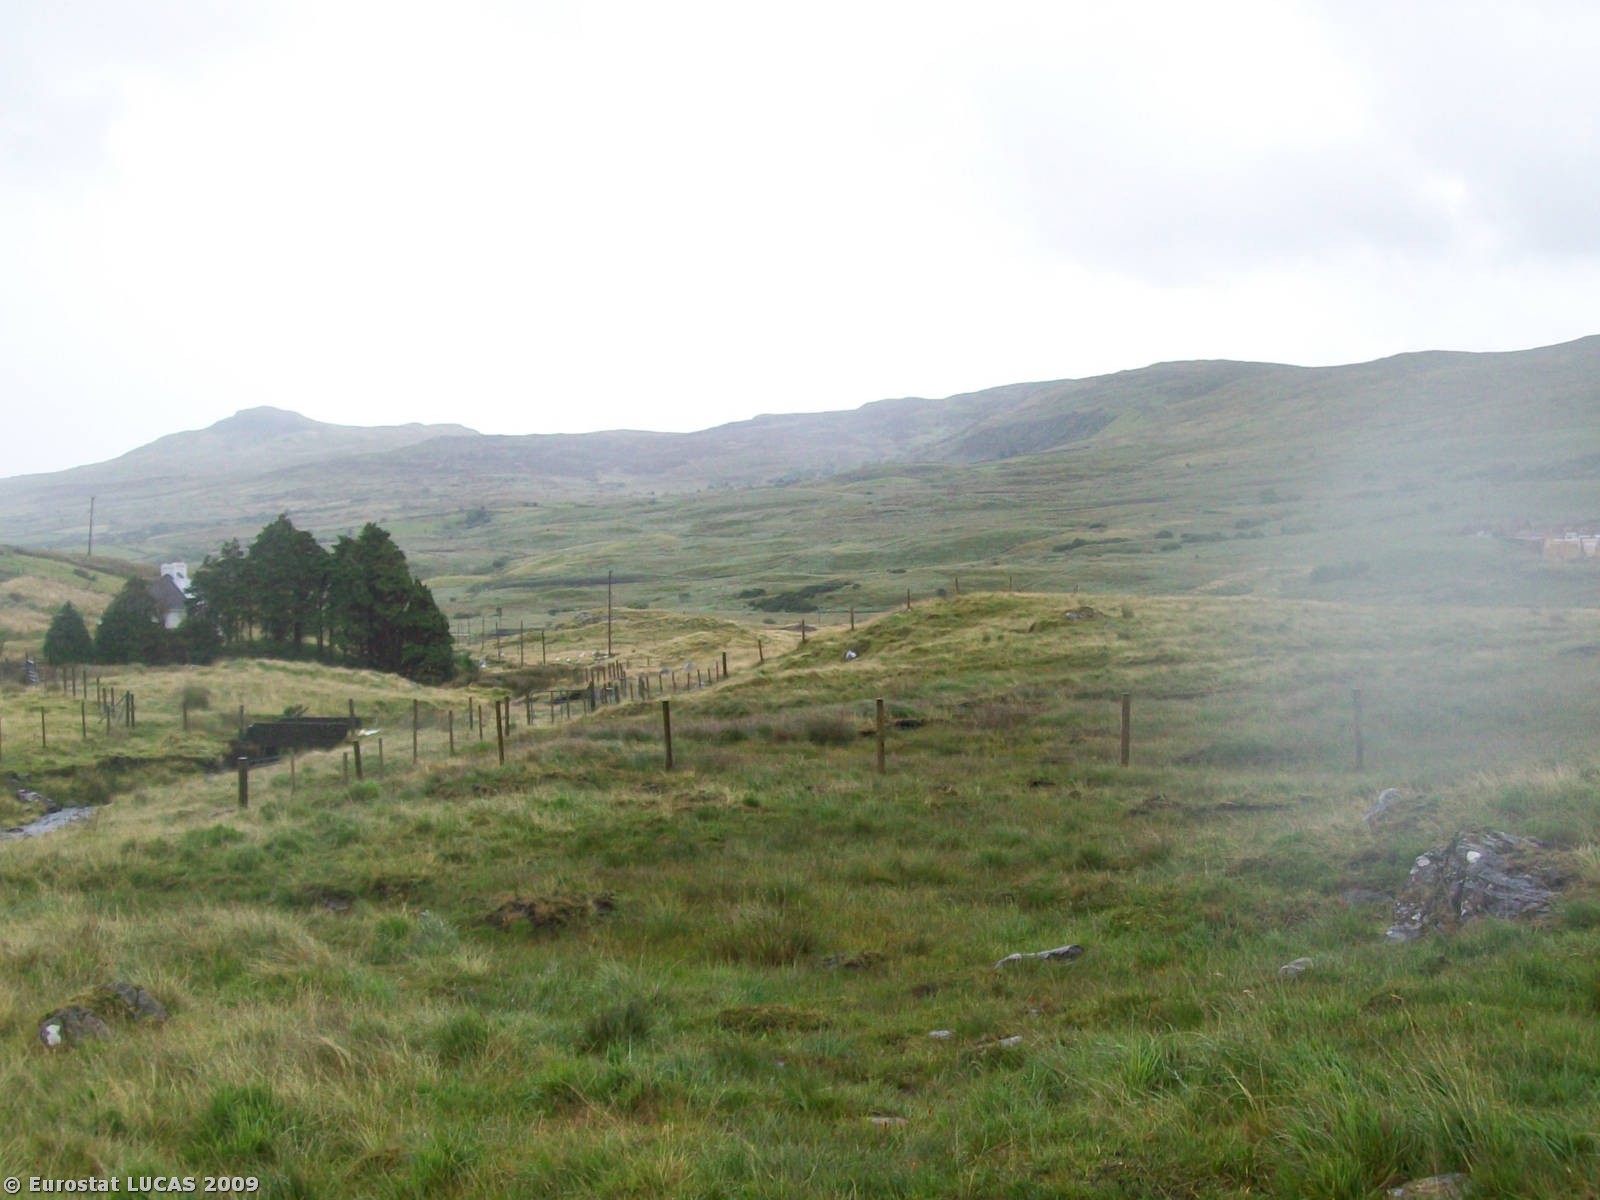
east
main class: Grassland
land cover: Grassland without tree/shrub cover
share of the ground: > 75 %
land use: Agriculture (excluding fallow land and kitchen gardens)
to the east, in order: Grassland without tree/shrub cover
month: July
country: IE
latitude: 53.5405
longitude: -9.4708
